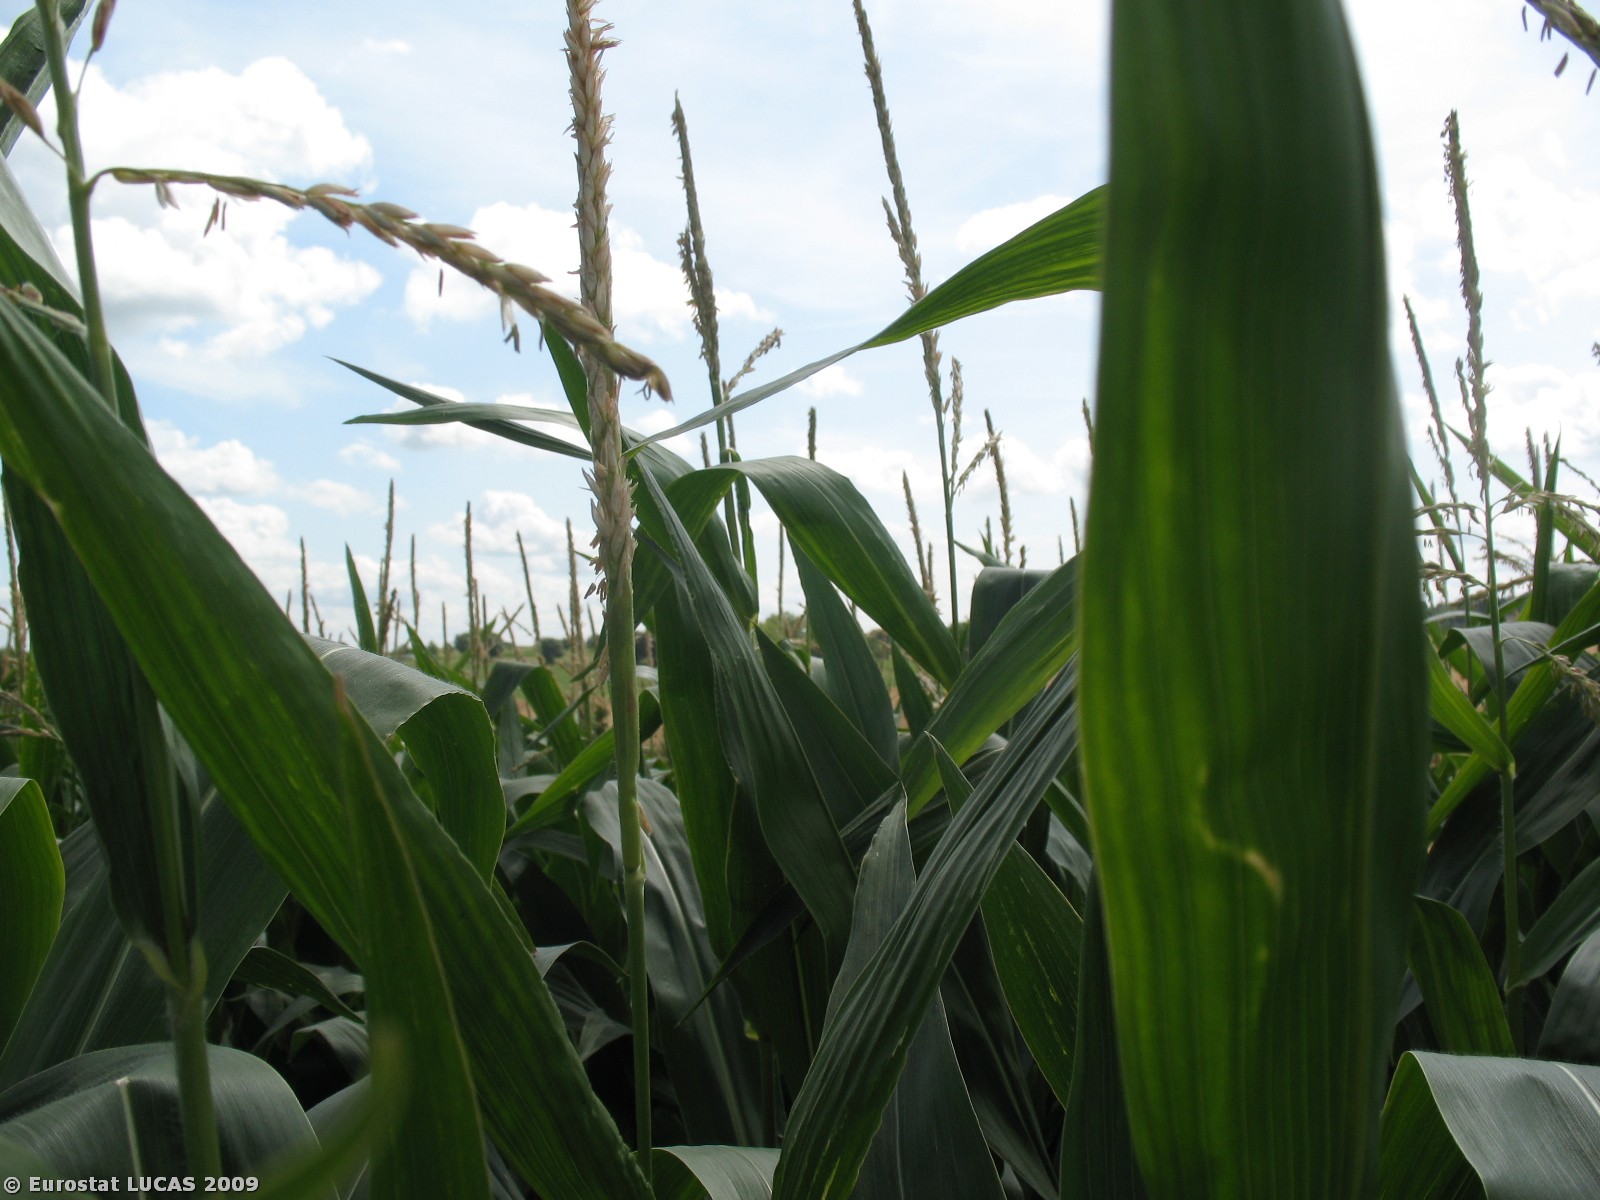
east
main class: Cropland
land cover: Maize
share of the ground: > 75 %
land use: Agriculture (excluding fallow land and kitchen gardens)
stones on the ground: < 10 %
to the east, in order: Maize; Grassland without tree/shrub cover; Ditches and canals; Bare land; Ditches and canals; Grassland without tree/shrub cover
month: July
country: BE
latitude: 50.8592
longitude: 3.7280
